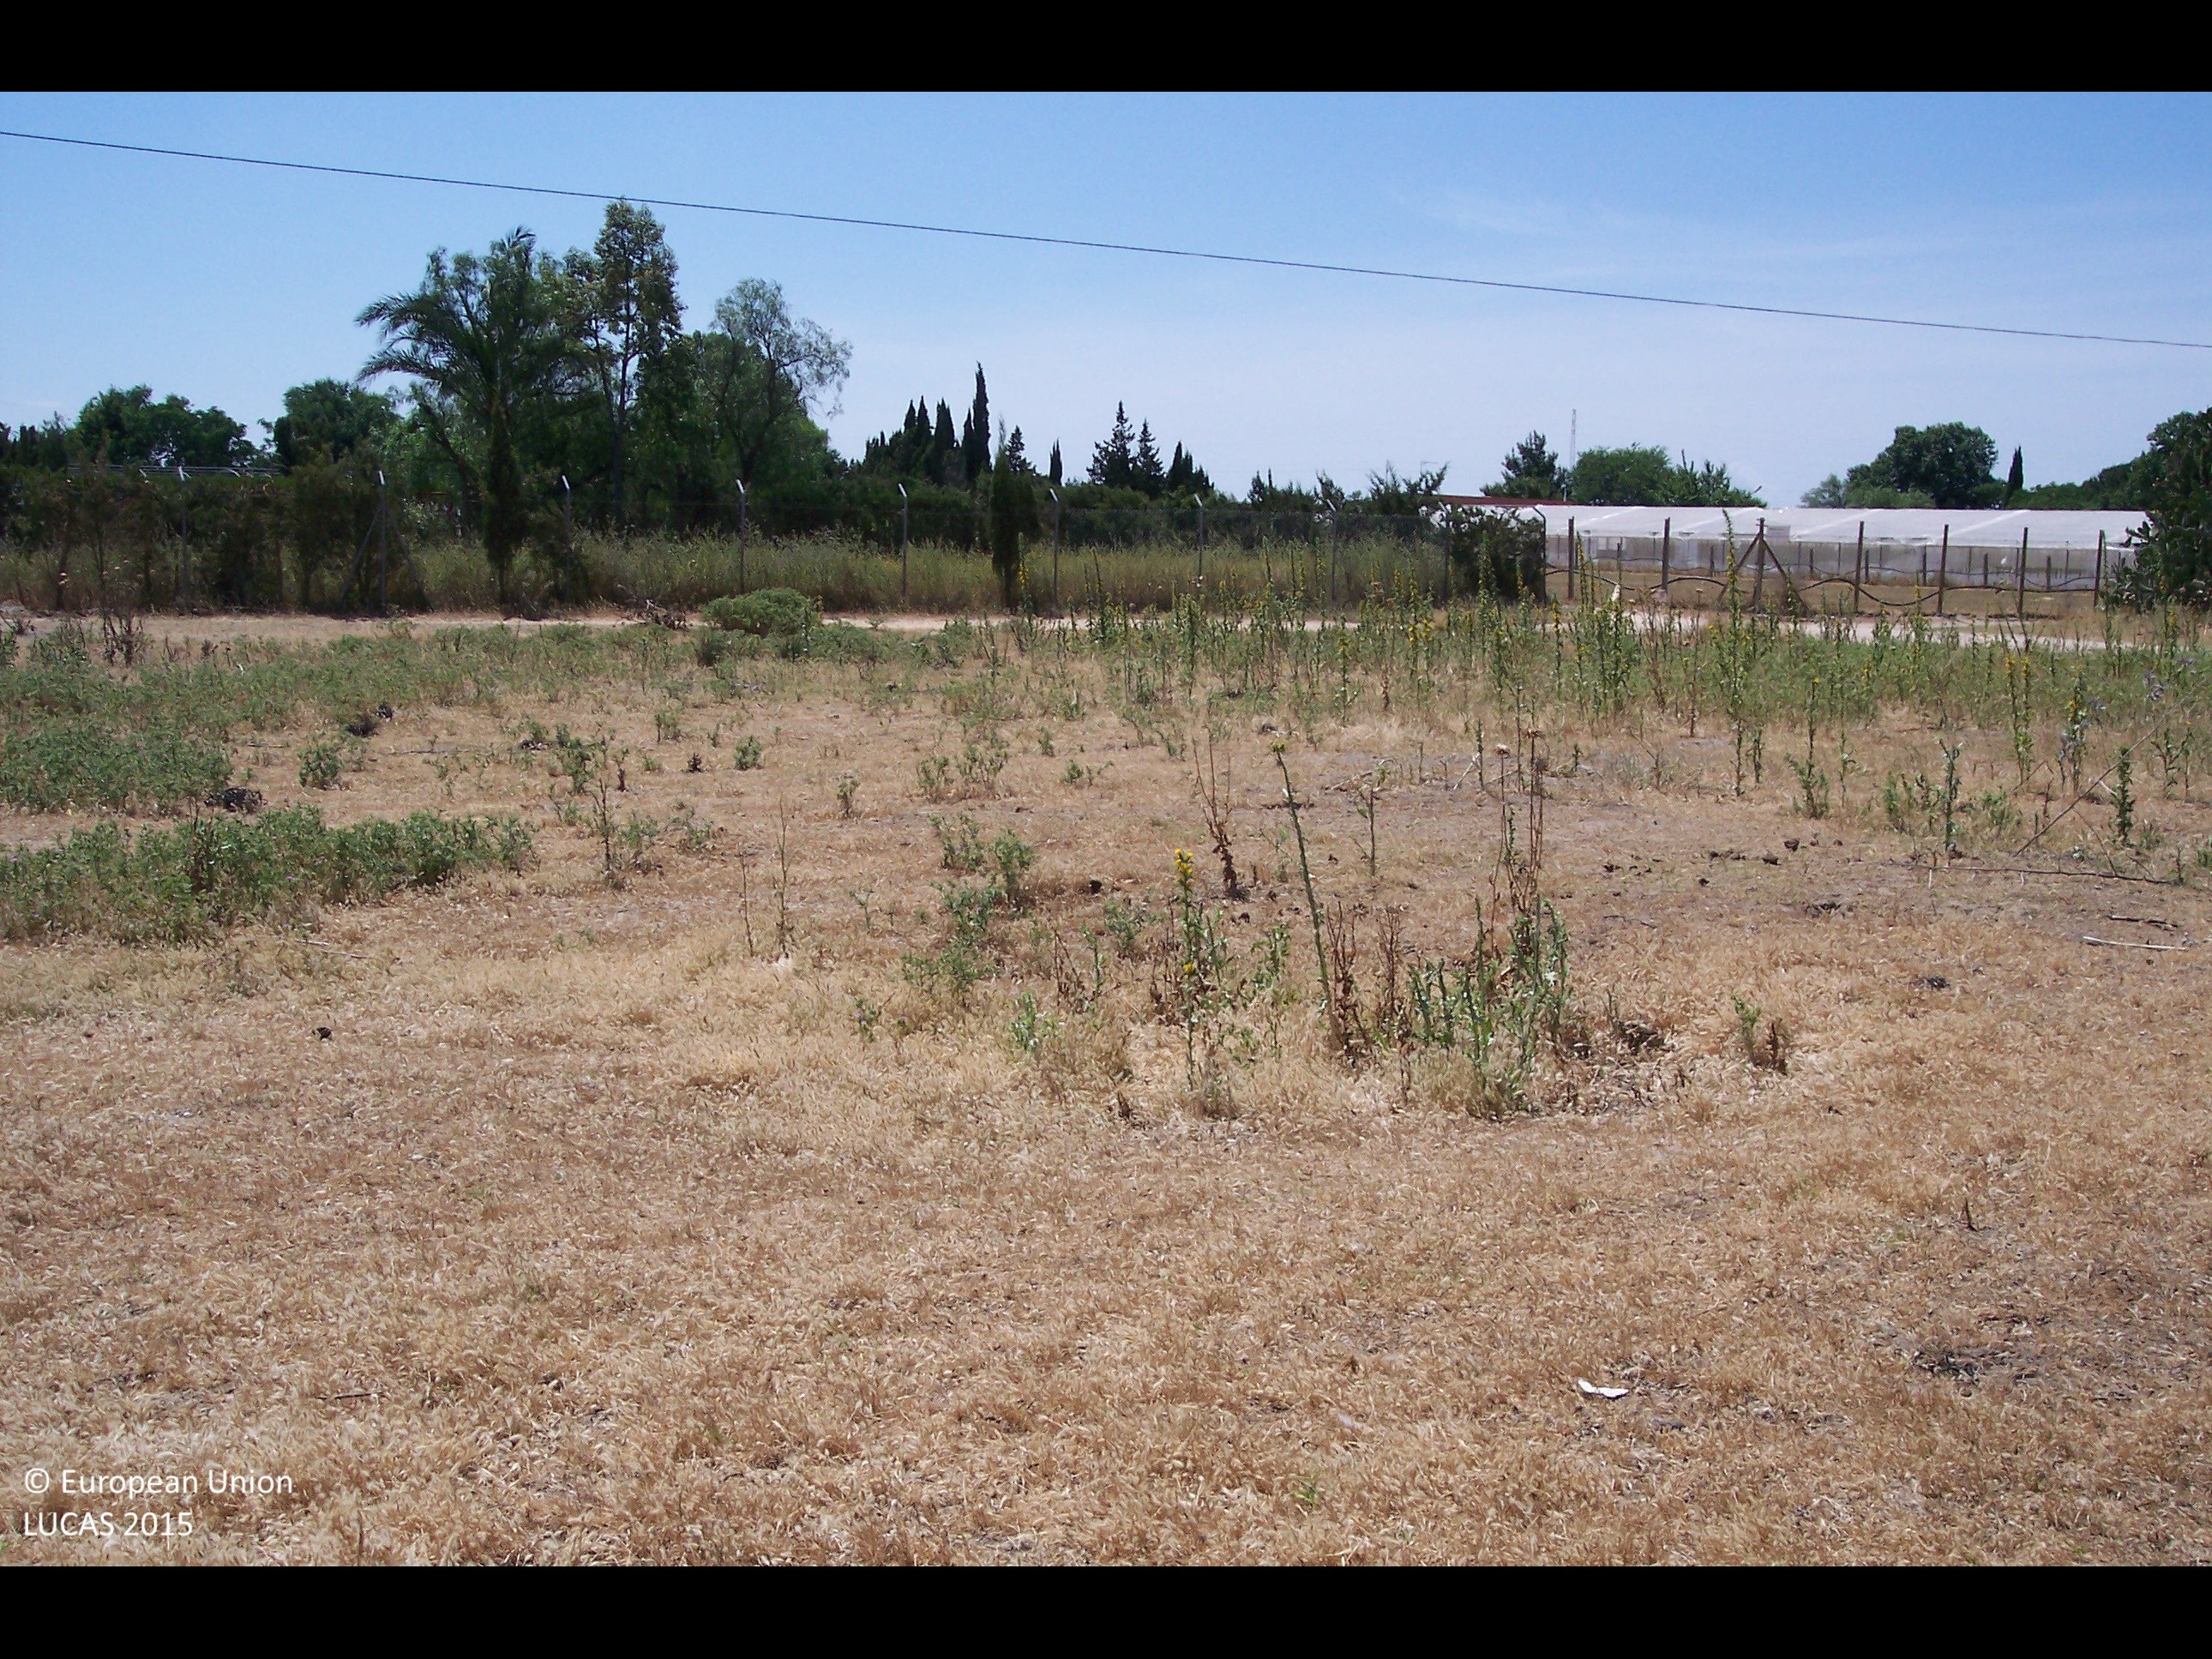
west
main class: Cropland
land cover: Permanent crops (only in case pi)
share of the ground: 50 - 75 %
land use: Agriculture (excluding fallow land and kitchen gardens)
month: May
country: ES
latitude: 37.1630
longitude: -5.8616
